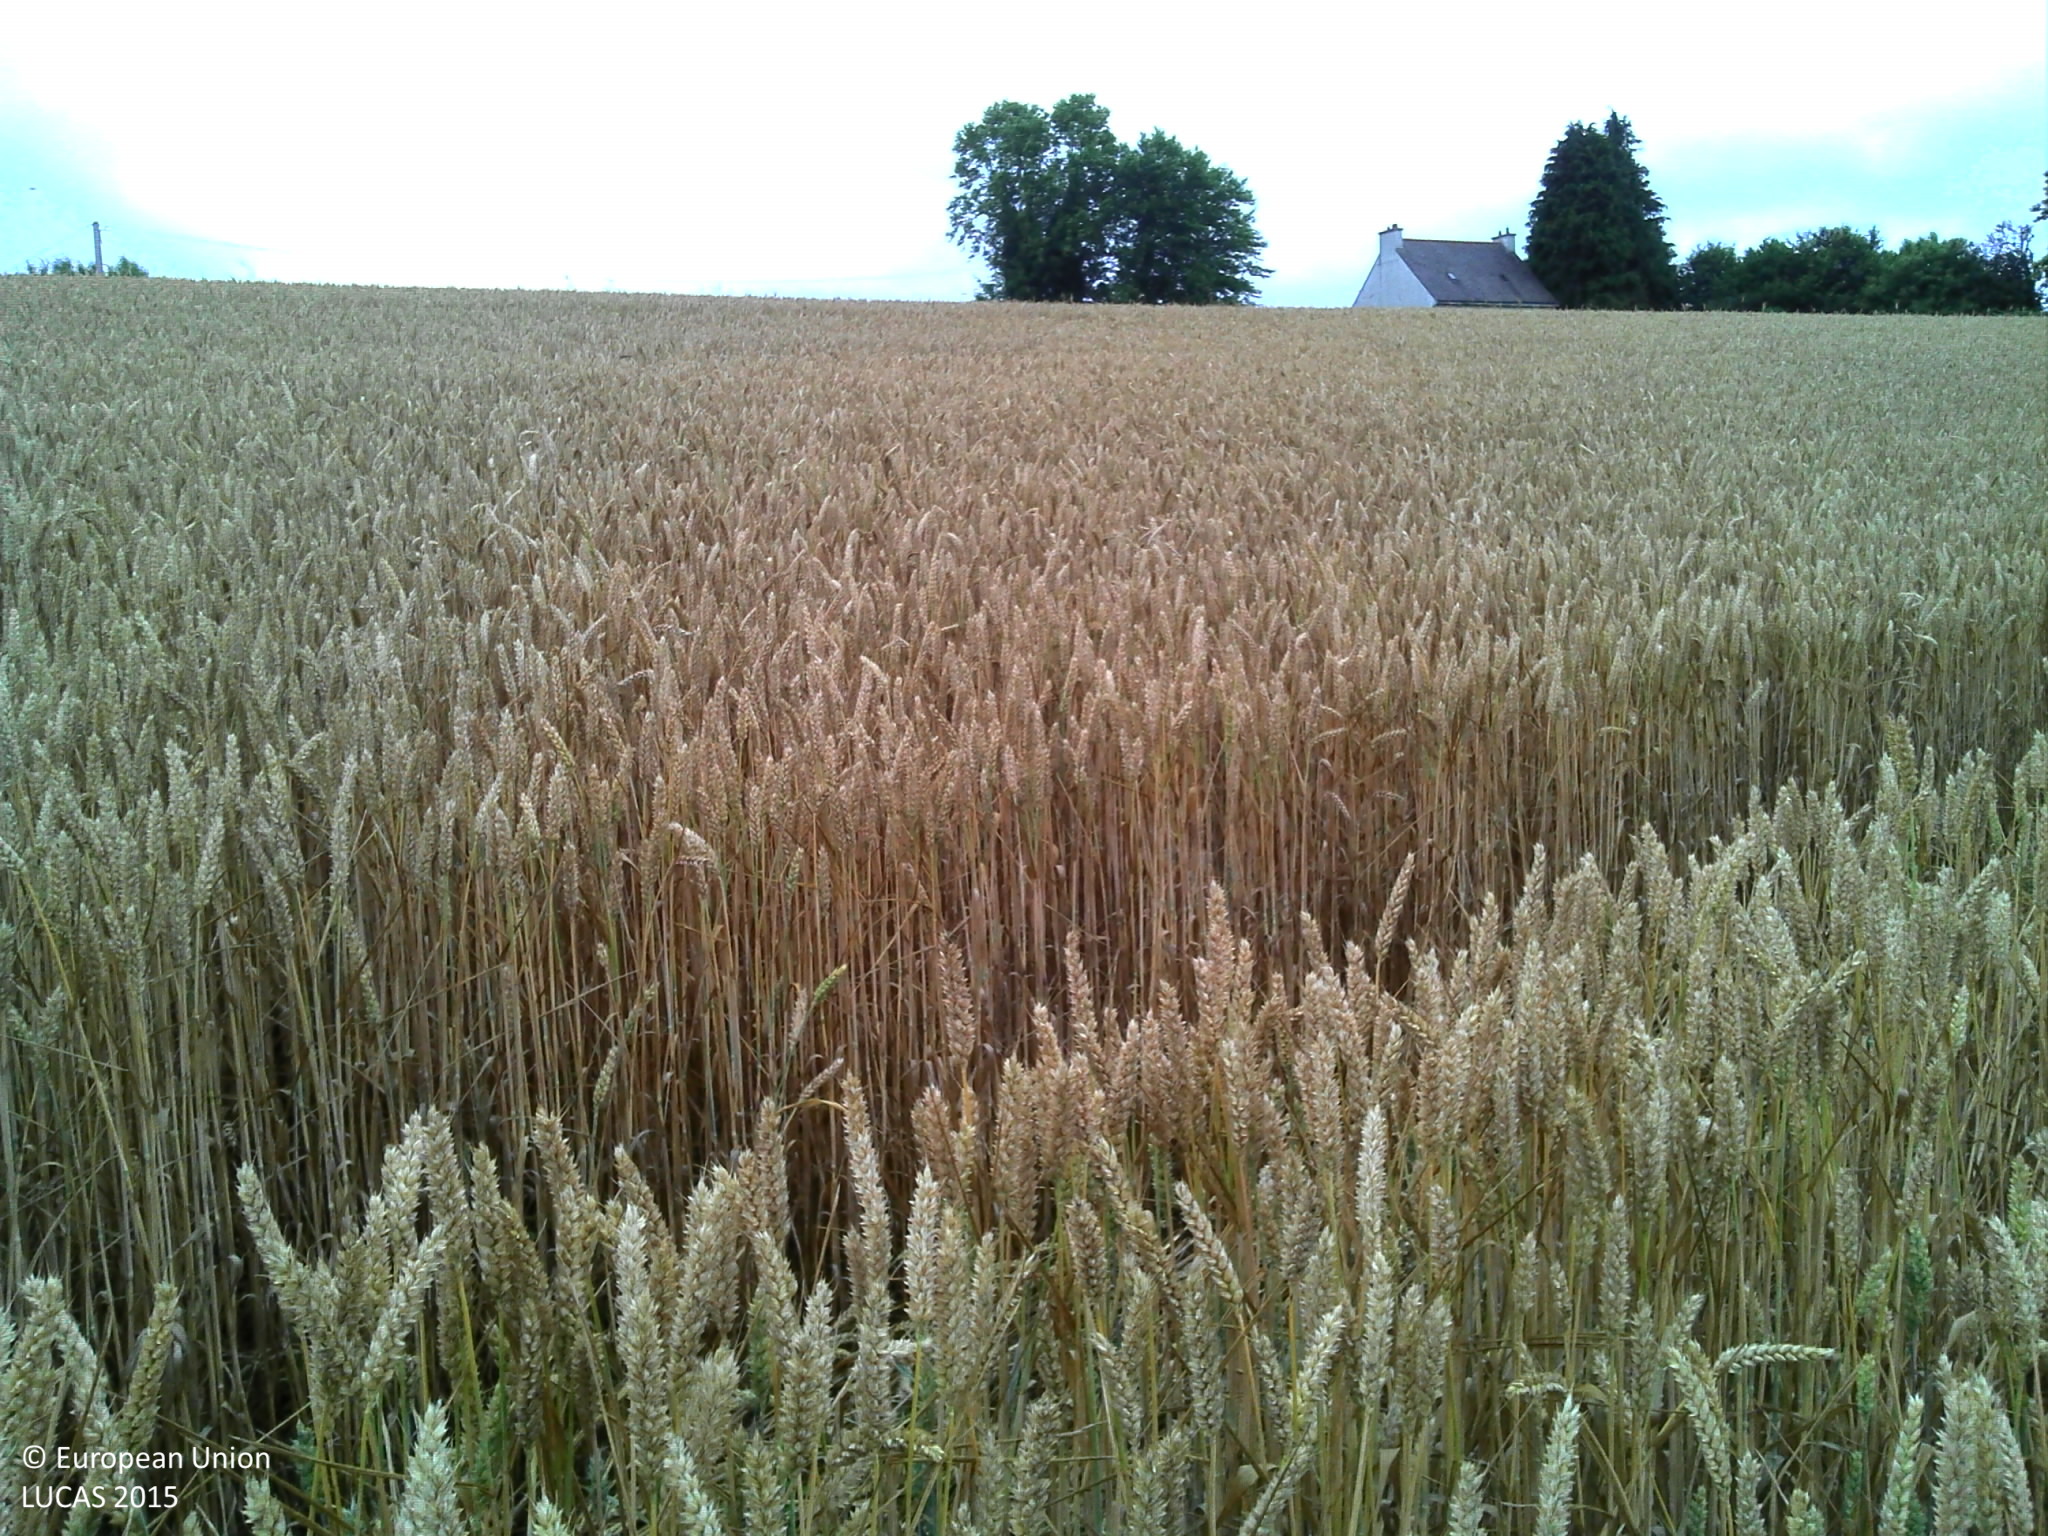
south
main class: Cropland
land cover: Common wheat
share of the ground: > 75 %
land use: Agriculture (excluding fallow land and kitchen gardens)
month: July
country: FR
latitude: 48.1262
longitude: -3.5813
